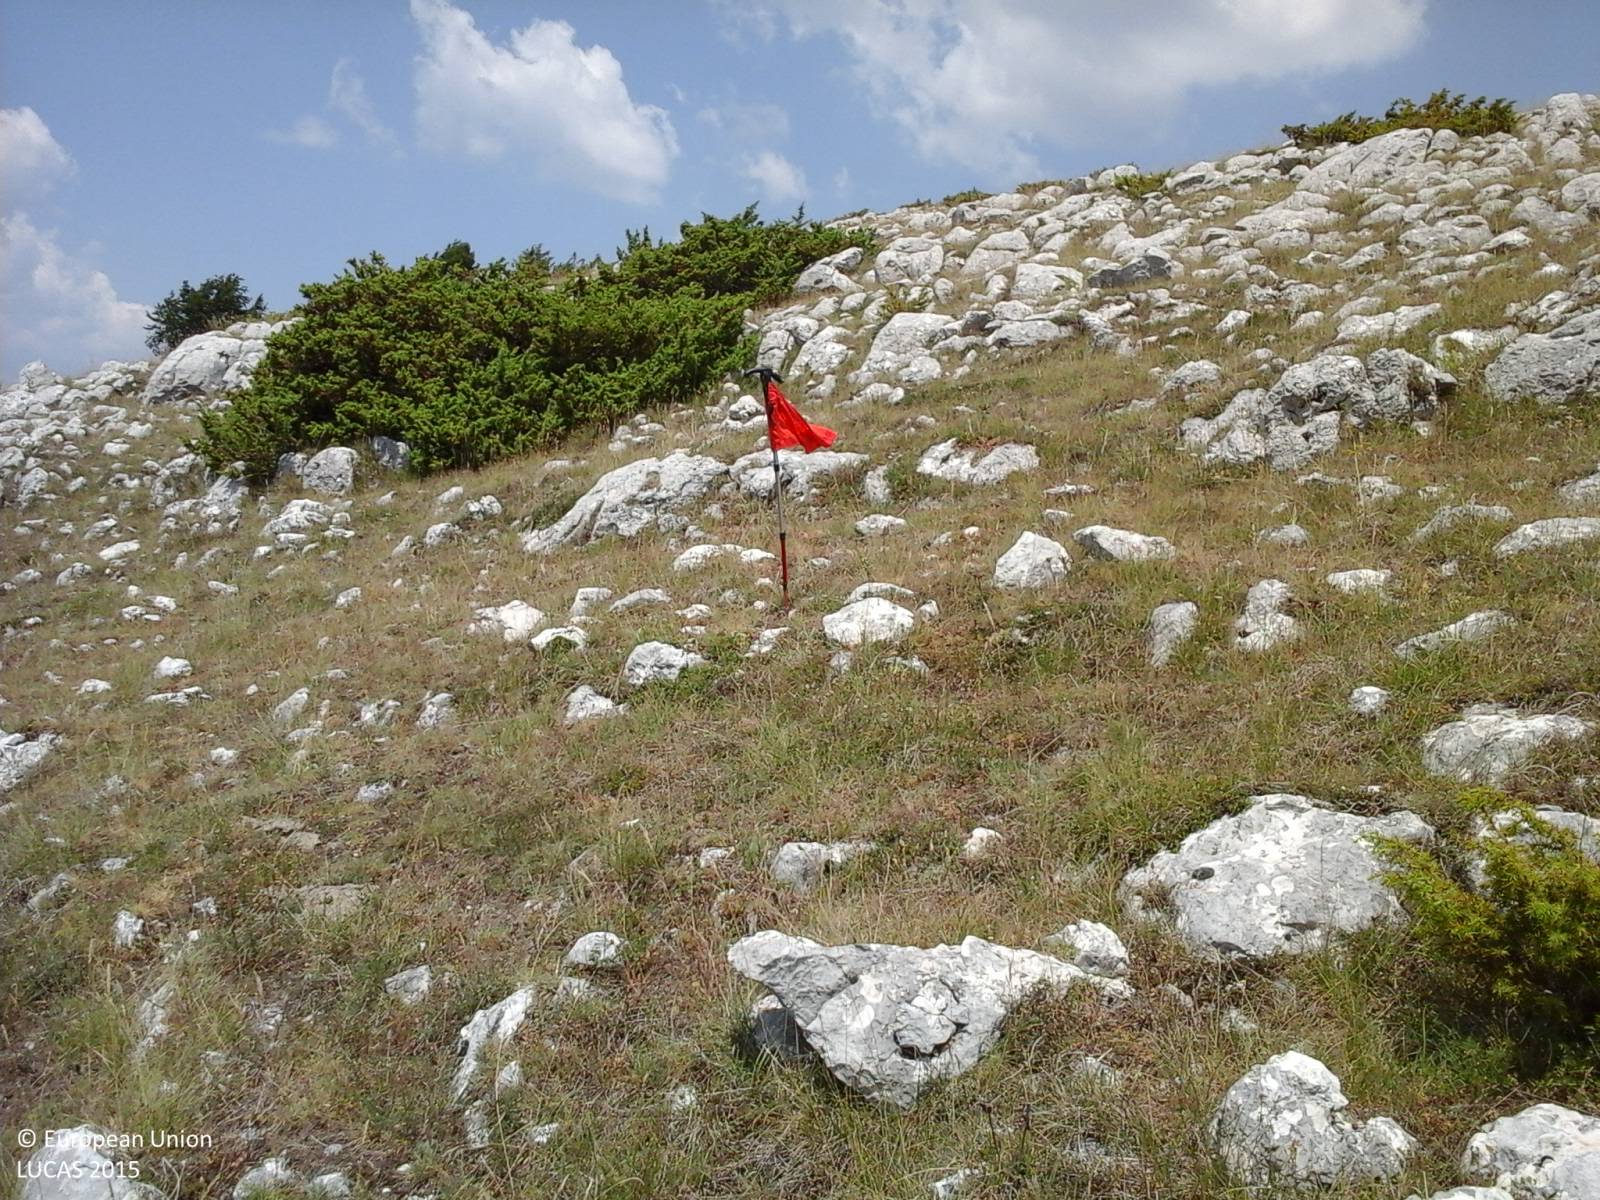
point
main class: Grassland
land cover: Grassland without tree/shrub cover
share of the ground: > 75 %
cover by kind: herbaceous plants 60 %, consolidated bare surface 40 %
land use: Agriculture (excluding fallow land and kitchen gardens)
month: July
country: IT
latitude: 42.2741
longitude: 13.3234
